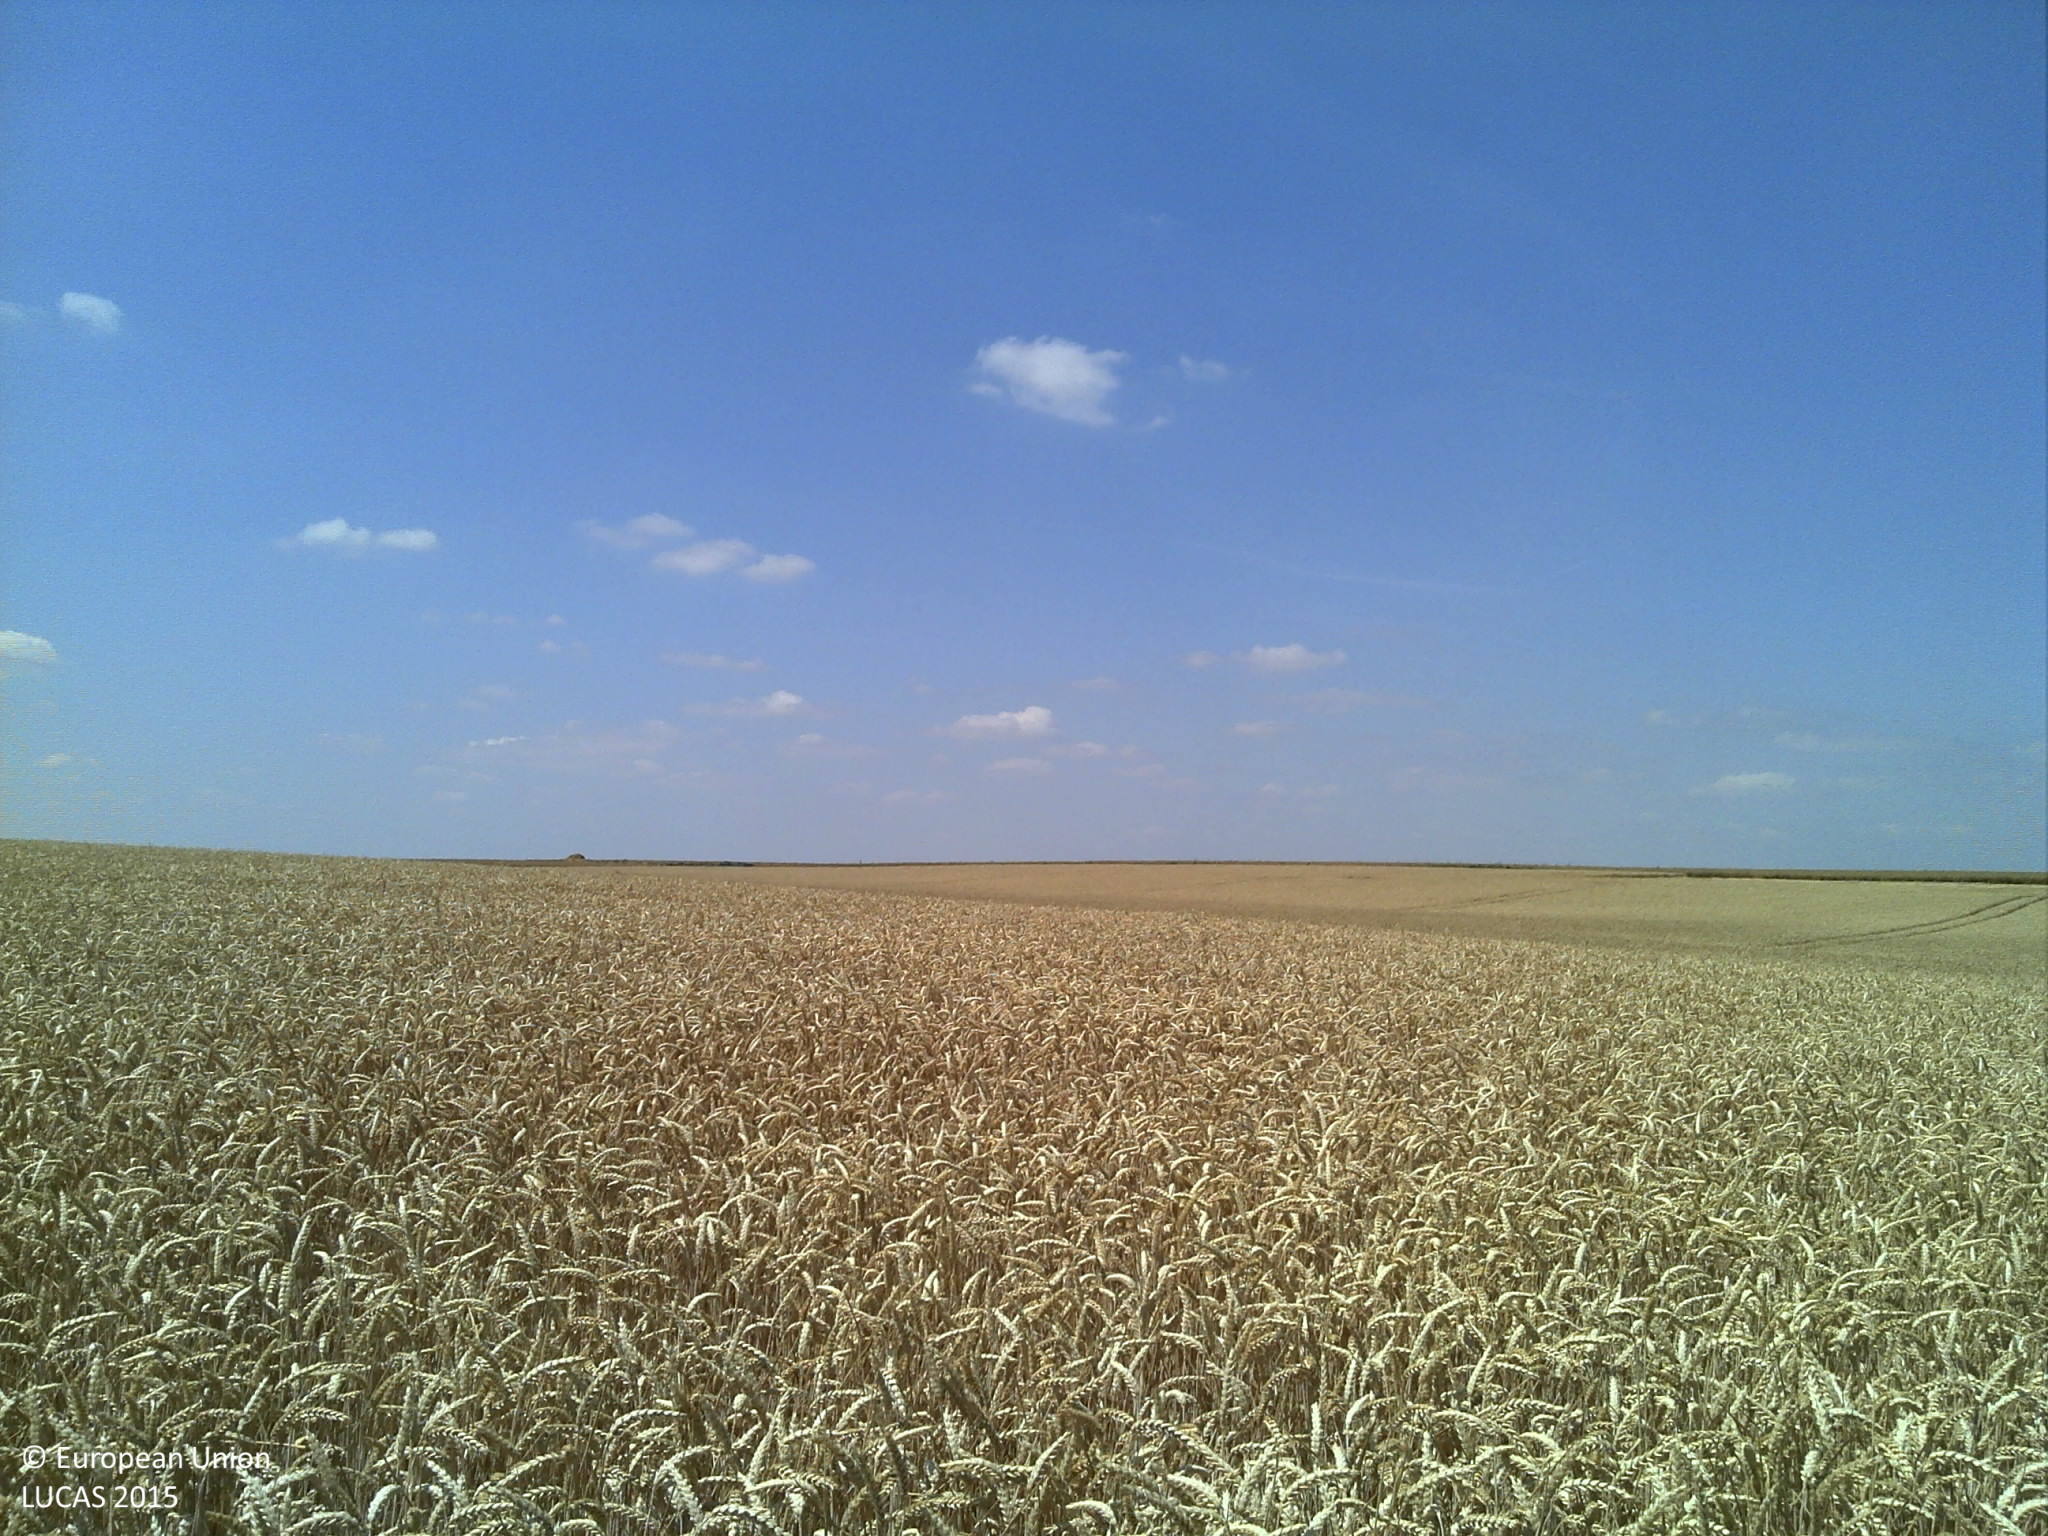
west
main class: Cropland
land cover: Common wheat
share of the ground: > 75 %
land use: Agriculture (excluding fallow land and kitchen gardens)
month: July
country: FR
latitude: 48.4903
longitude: 1.9623
